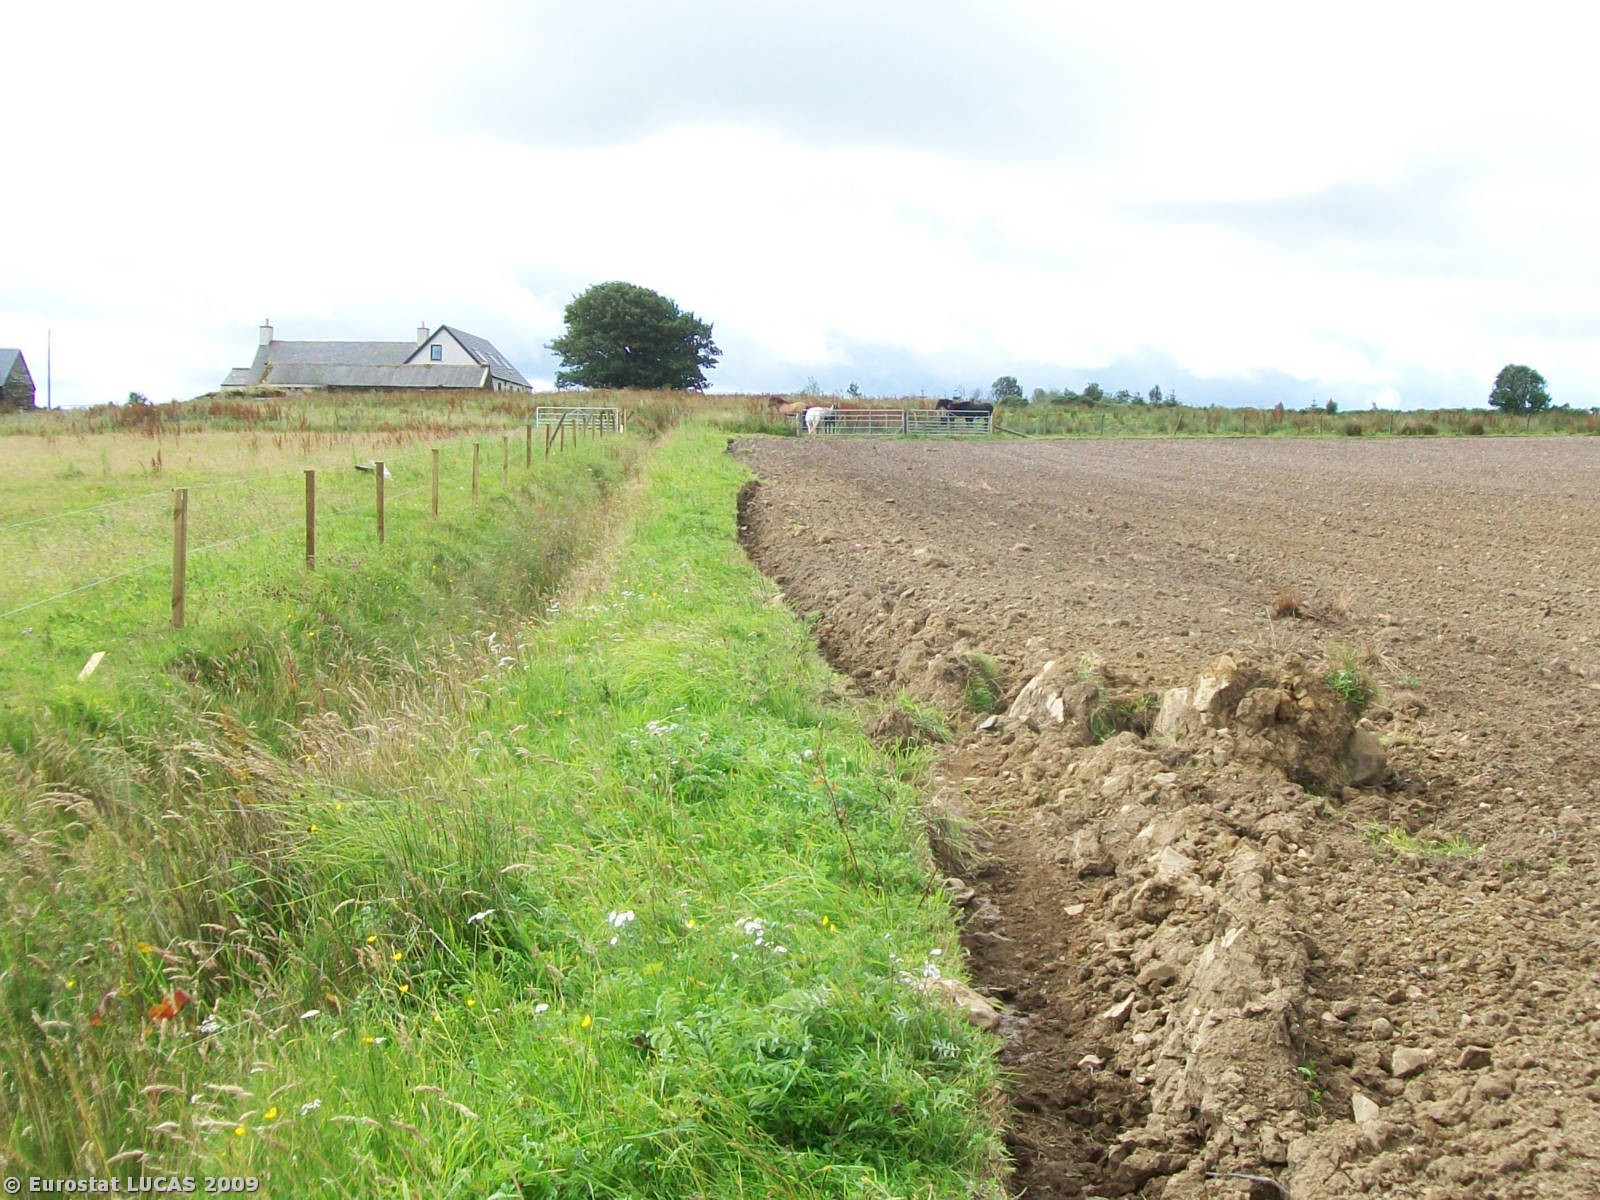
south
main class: Cropland
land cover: Temporary grasslands
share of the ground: > 75 %
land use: Agriculture (excluding fallow land and kitchen gardens)
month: August
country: GB
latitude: 58.5055
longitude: -3.2926
